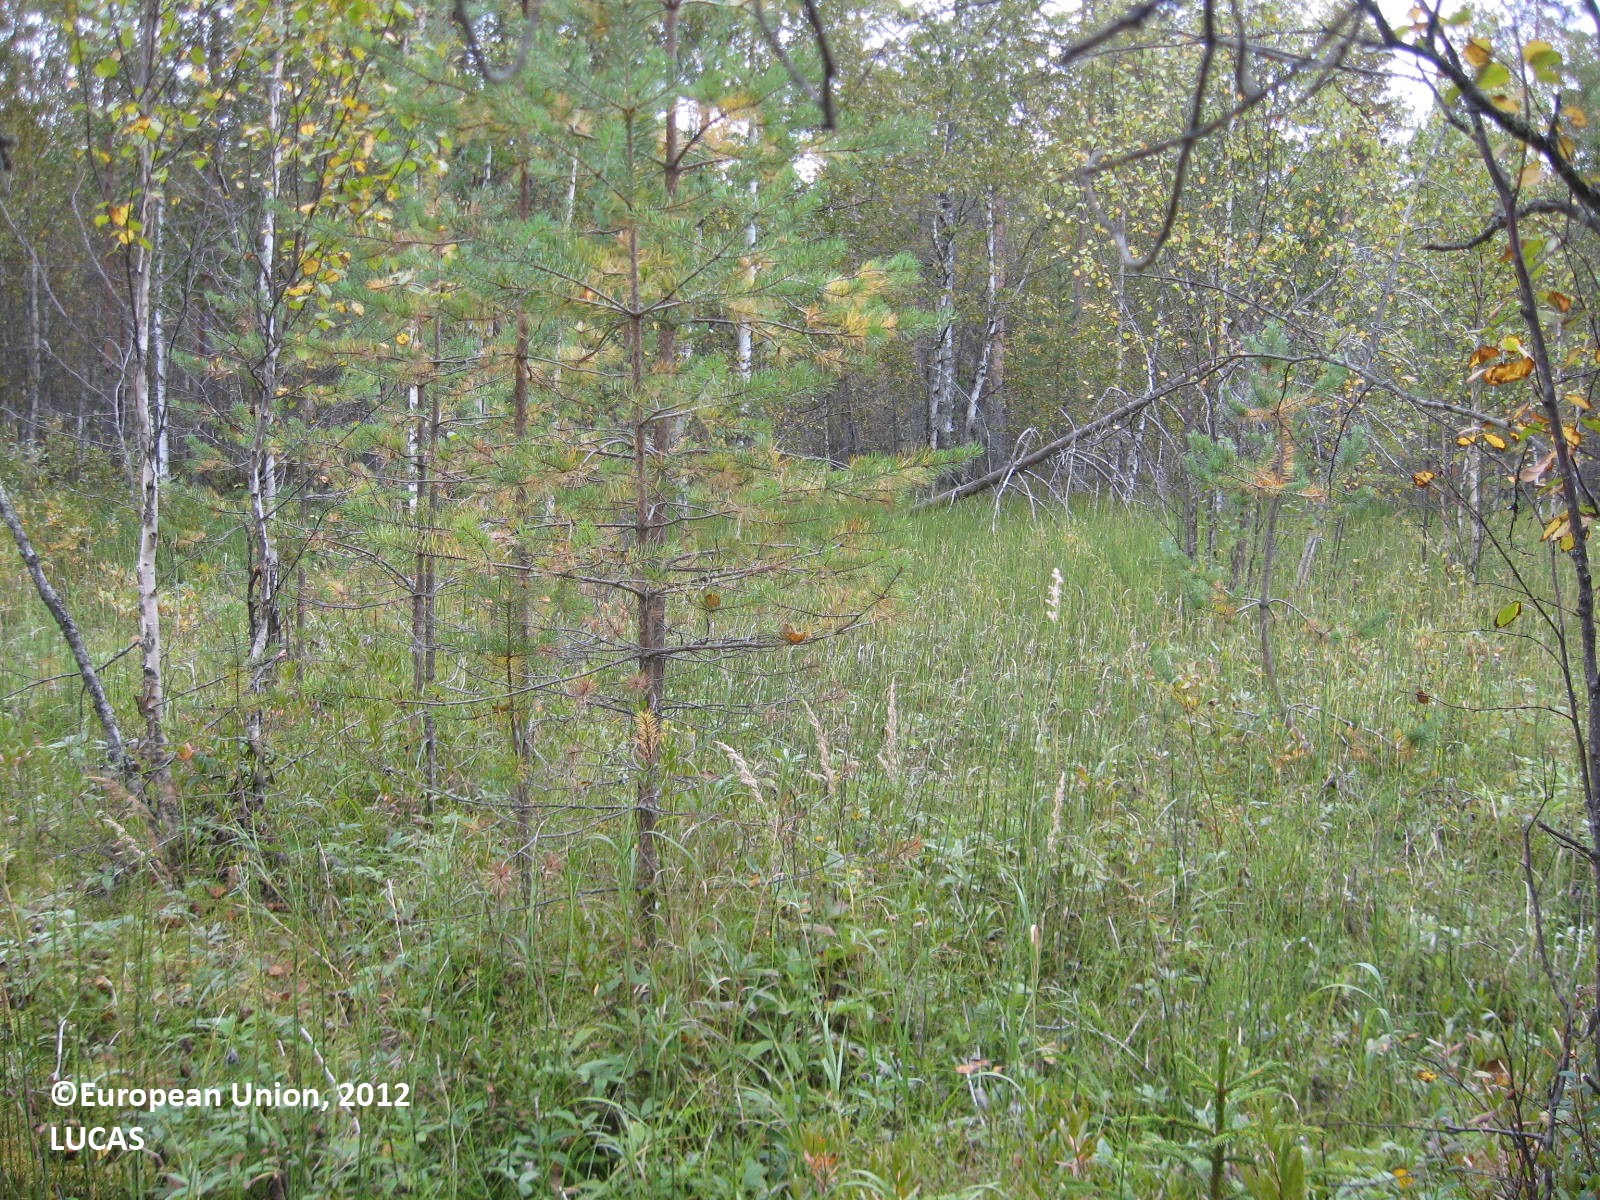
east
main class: Woodland
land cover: Other mixed woodland
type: boreal forest
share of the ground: > 75 %
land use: Forestry
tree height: > 5 m
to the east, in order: Other mixed woodland; Tracks; Shruby margins; Ditches and canals; Spruce dominated mixed woodland; Ditches and canals; Shruby margins; Spruce dominated mixed woodland
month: September
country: FI
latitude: 64.0995
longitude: 28.1649
